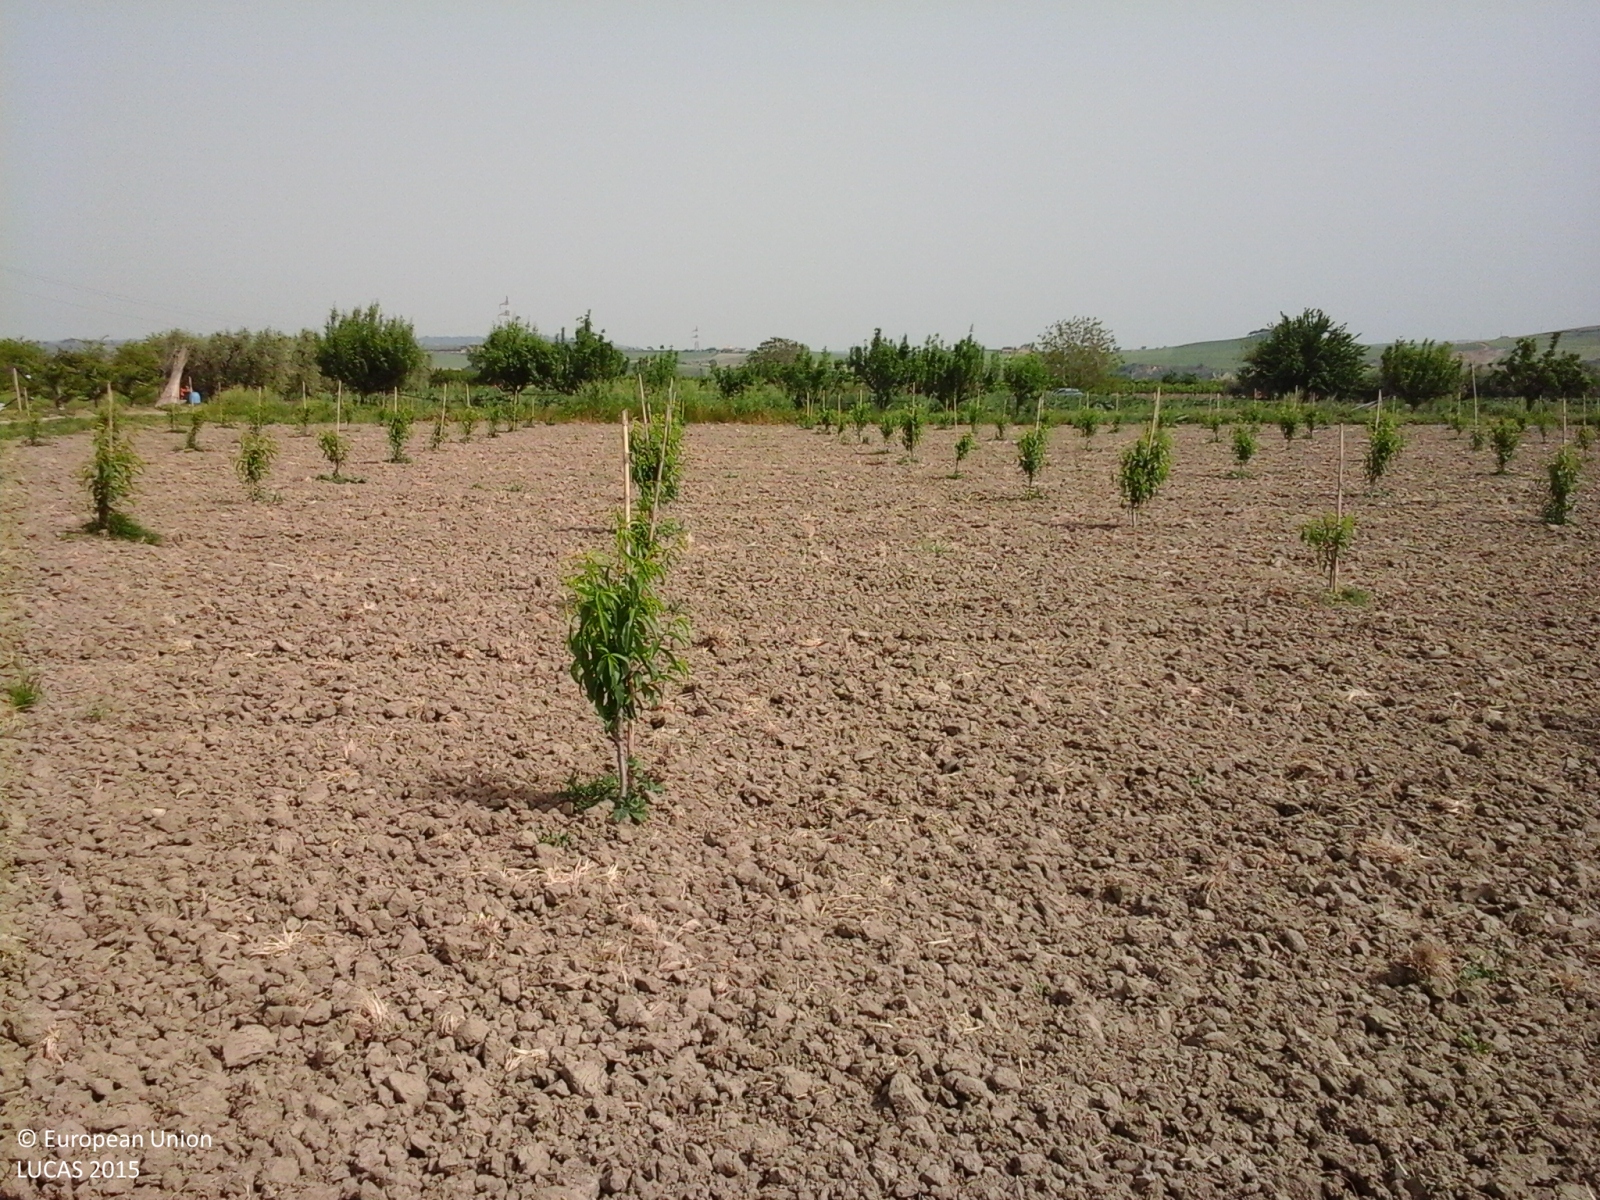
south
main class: Cropland
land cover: Other fruit trees and berries
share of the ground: 25 - 50 %
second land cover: Other bare soil
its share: > 75 %
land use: Agriculture (excluding fallow land and kitchen gardens)
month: May
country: IT
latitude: 42.0188
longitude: 14.7313
